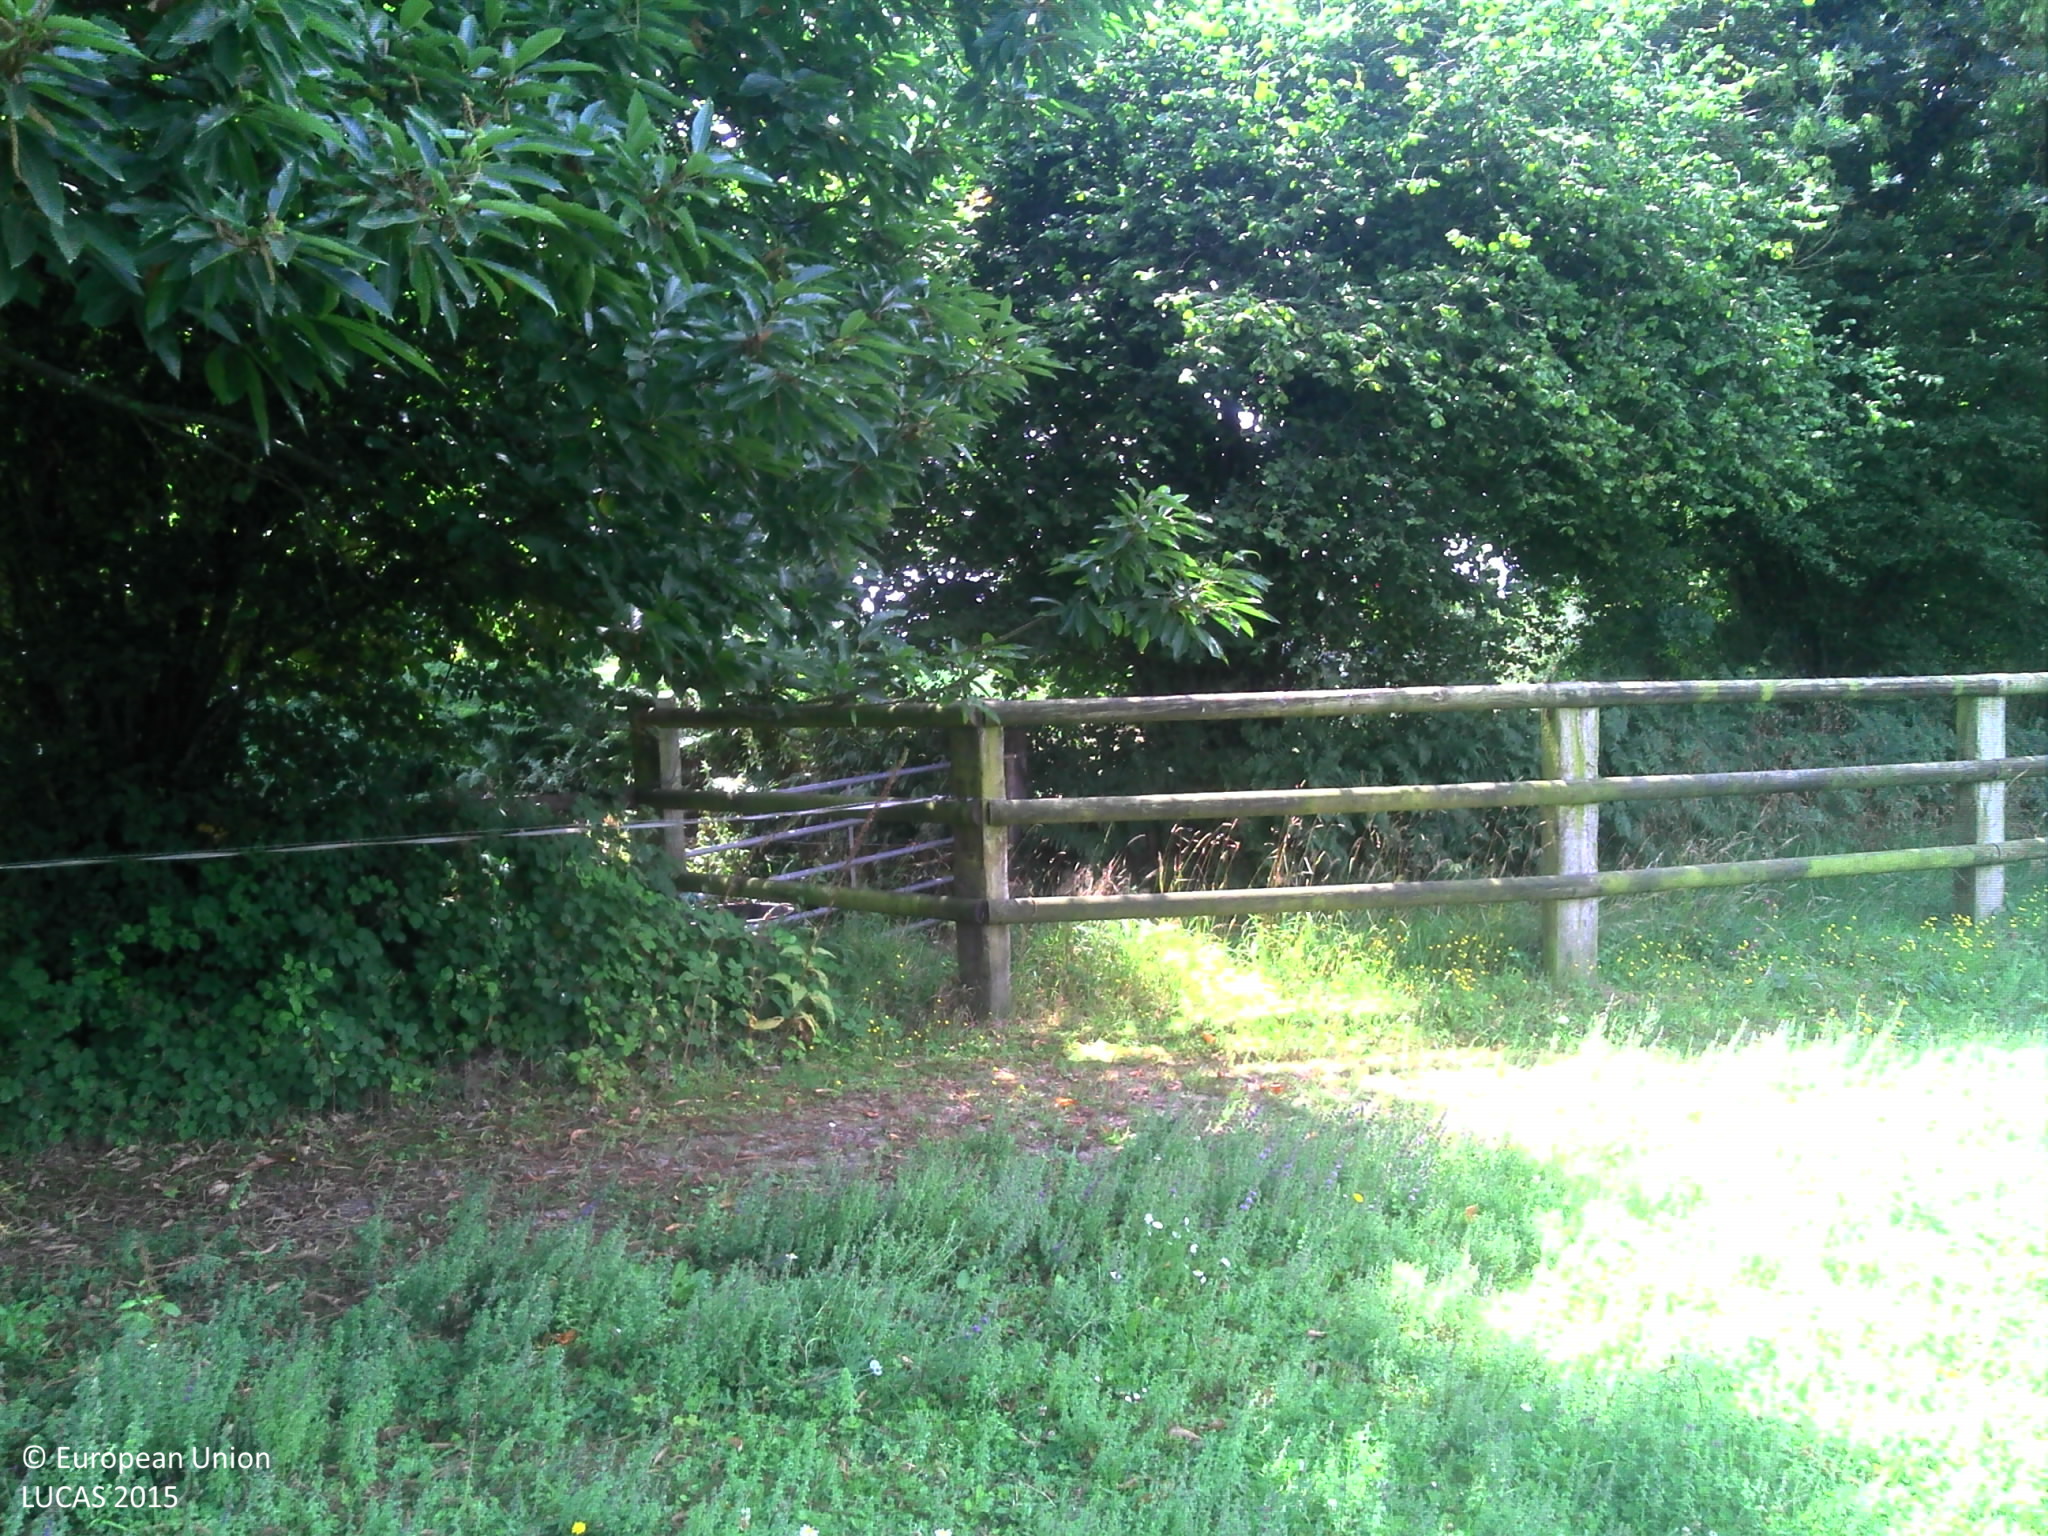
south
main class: Grassland
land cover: Grassland without tree/shrub cover
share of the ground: > 75 %
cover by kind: herbaceous plants 100 %
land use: Agriculture (excluding fallow land and kitchen gardens)
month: July
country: FR
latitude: 48.7794
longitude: -1.3548
